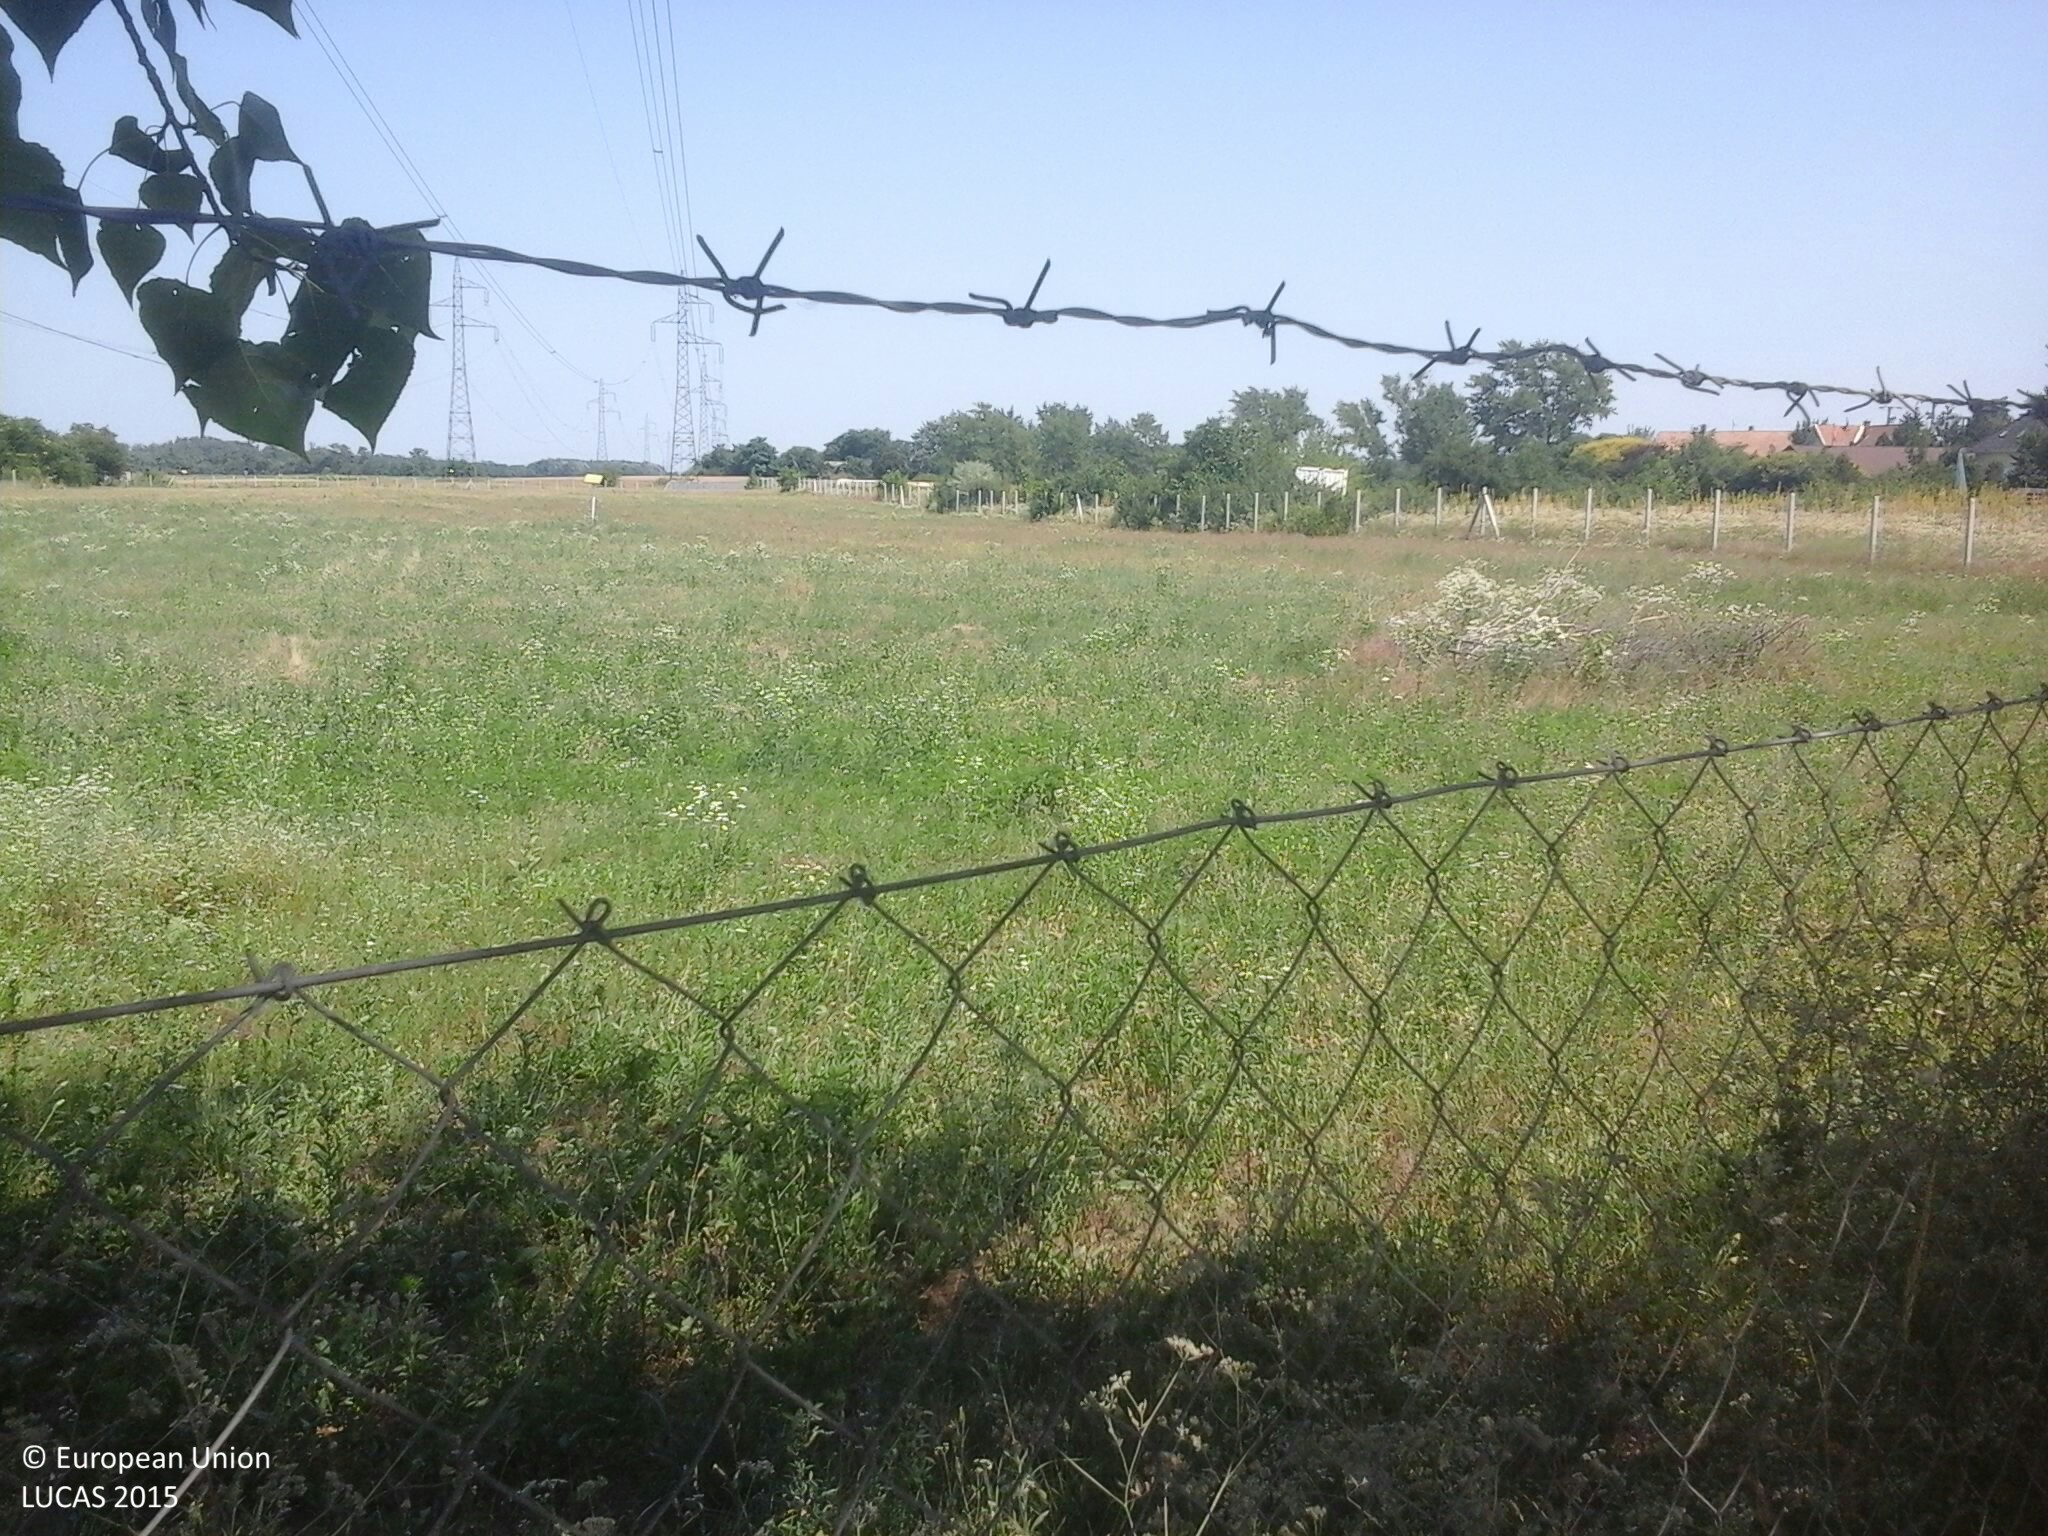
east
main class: Grassland
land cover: Spontaneously vegetated surfaces
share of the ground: > 75 %
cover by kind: herbaceous plants 100 %
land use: Semi-natural and natural areas not in use
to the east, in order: Spontaneously vegetated surfaces; Fences; Grass margins; Paved roads, cycling and walking lanes; Grassland without tree/shrub cover; Electric lines; Grassland without tree/shrub cover
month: July
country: HU
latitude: 47.2694
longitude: 19.0712
